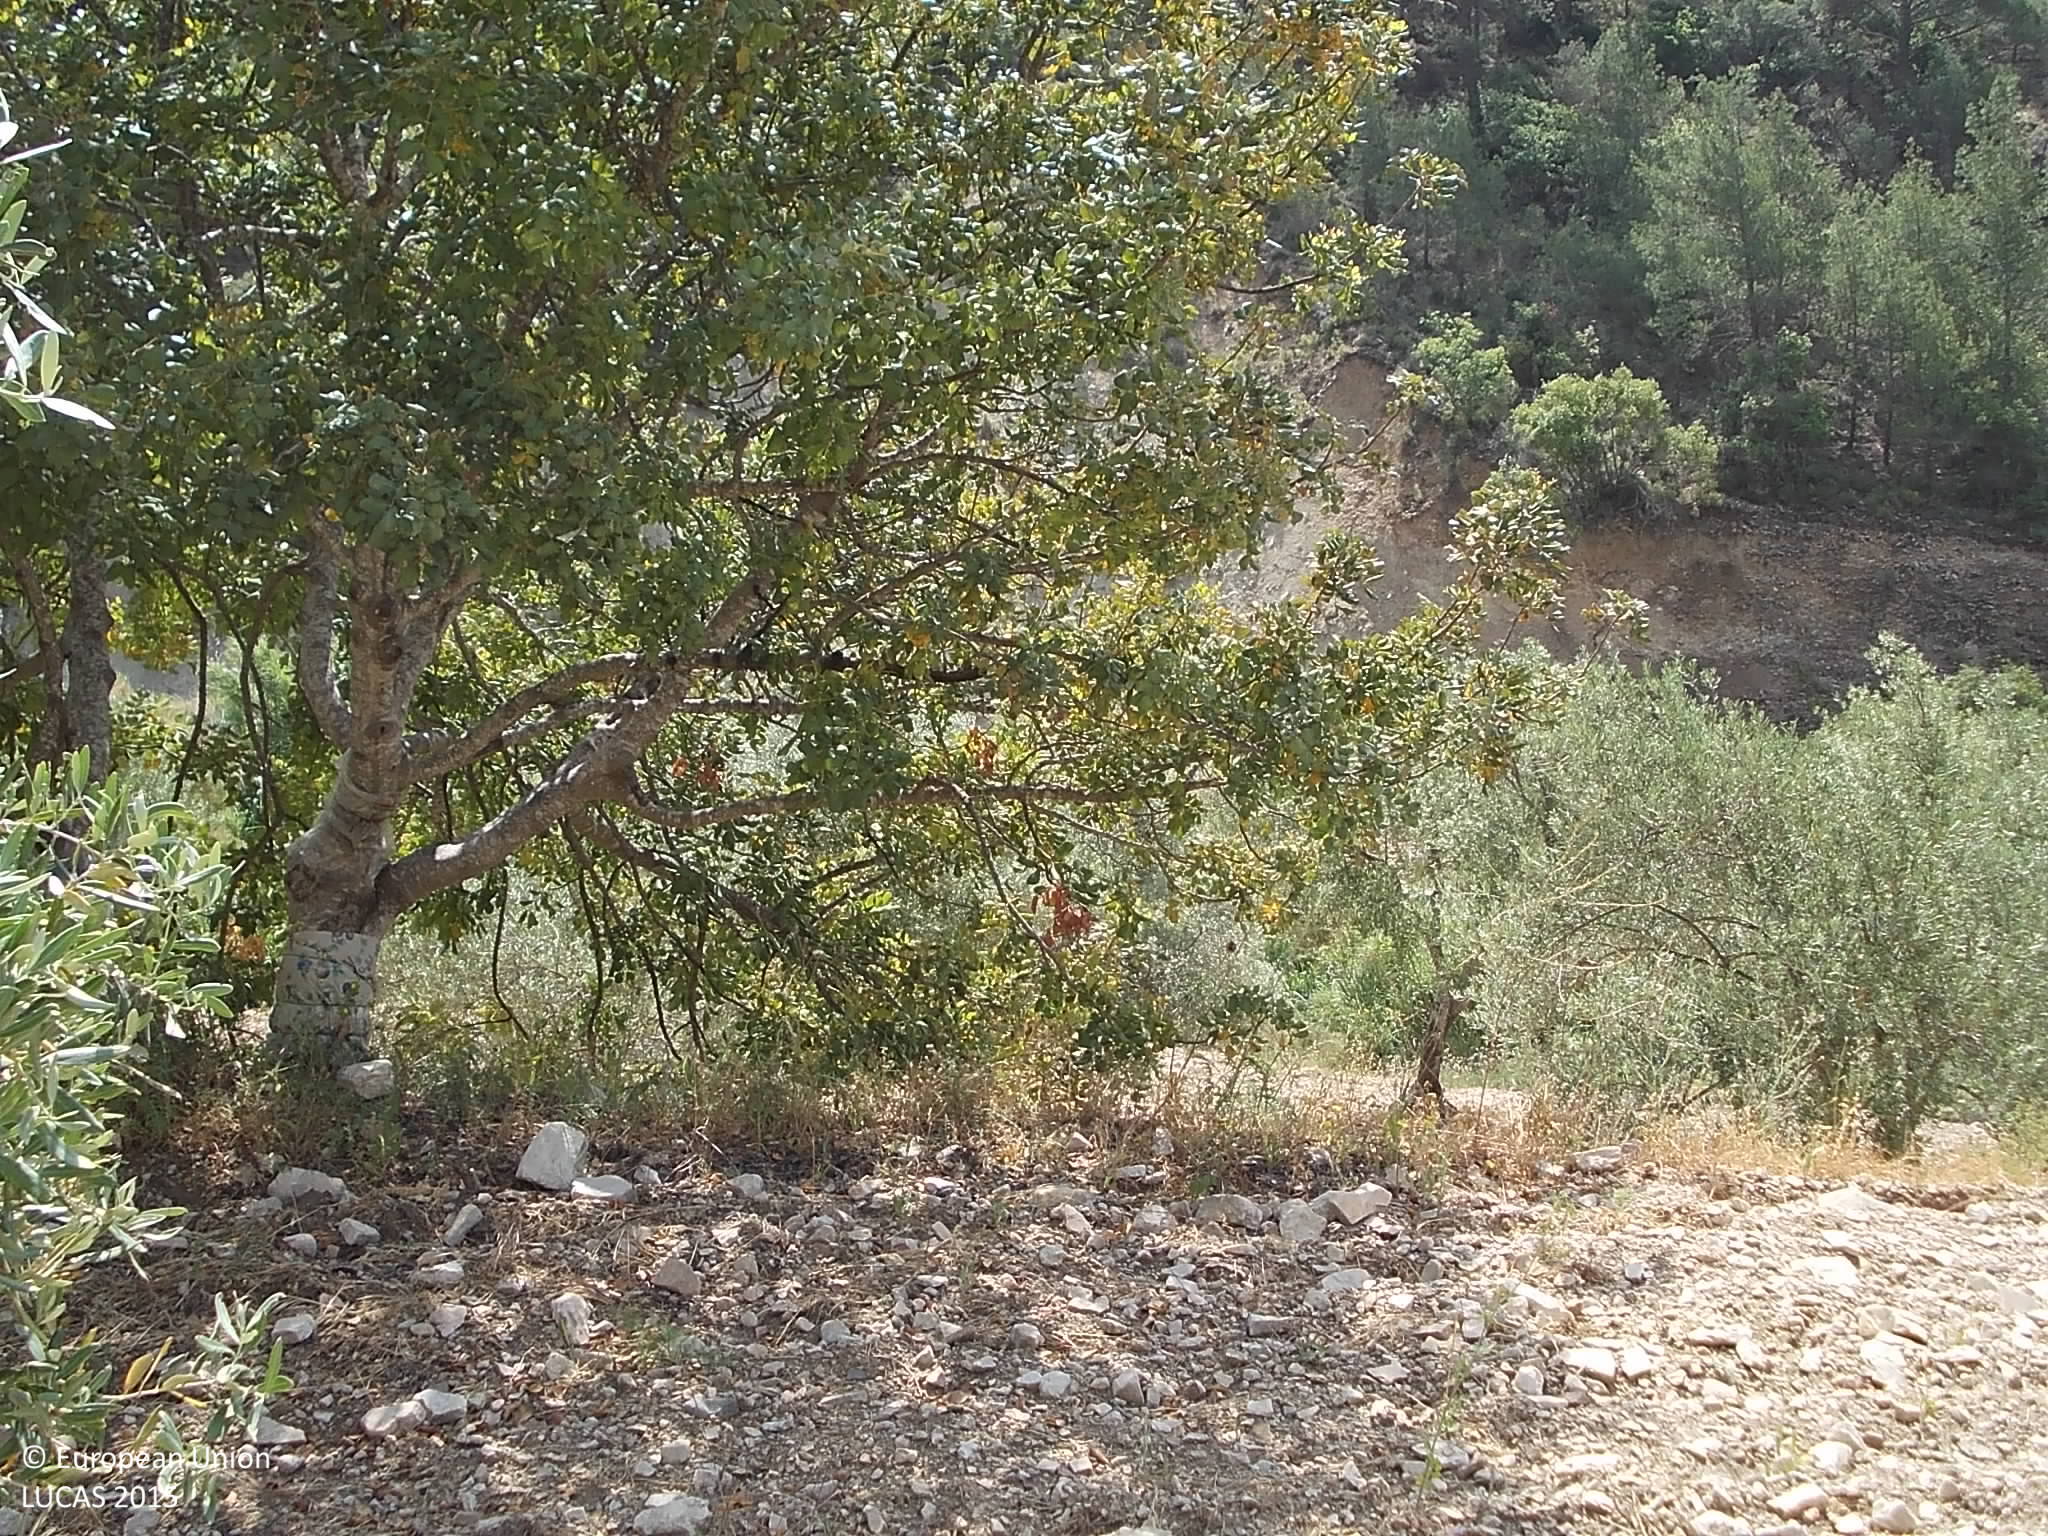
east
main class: Cropland
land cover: Olive groves
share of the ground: 25 - 50 %
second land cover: Rocks and stones
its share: > 75 %
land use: Agriculture (excluding fallow land and kitchen gardens)
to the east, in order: Olive groves; Rocks and stones; Grass margins; Olive groves; Shruby margins; Tracks; Grassland without tree/shrub cover; Rivers and streams; Grassland without tree/shrub cover; Tracks; Paved roads, cycling and walking lanes; Pine dominated coniferous woodland; Shrubland with sparse tree cover; Pine dominated coniferous woodland
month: May
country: CY
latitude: 34.7943
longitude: 32.9986
